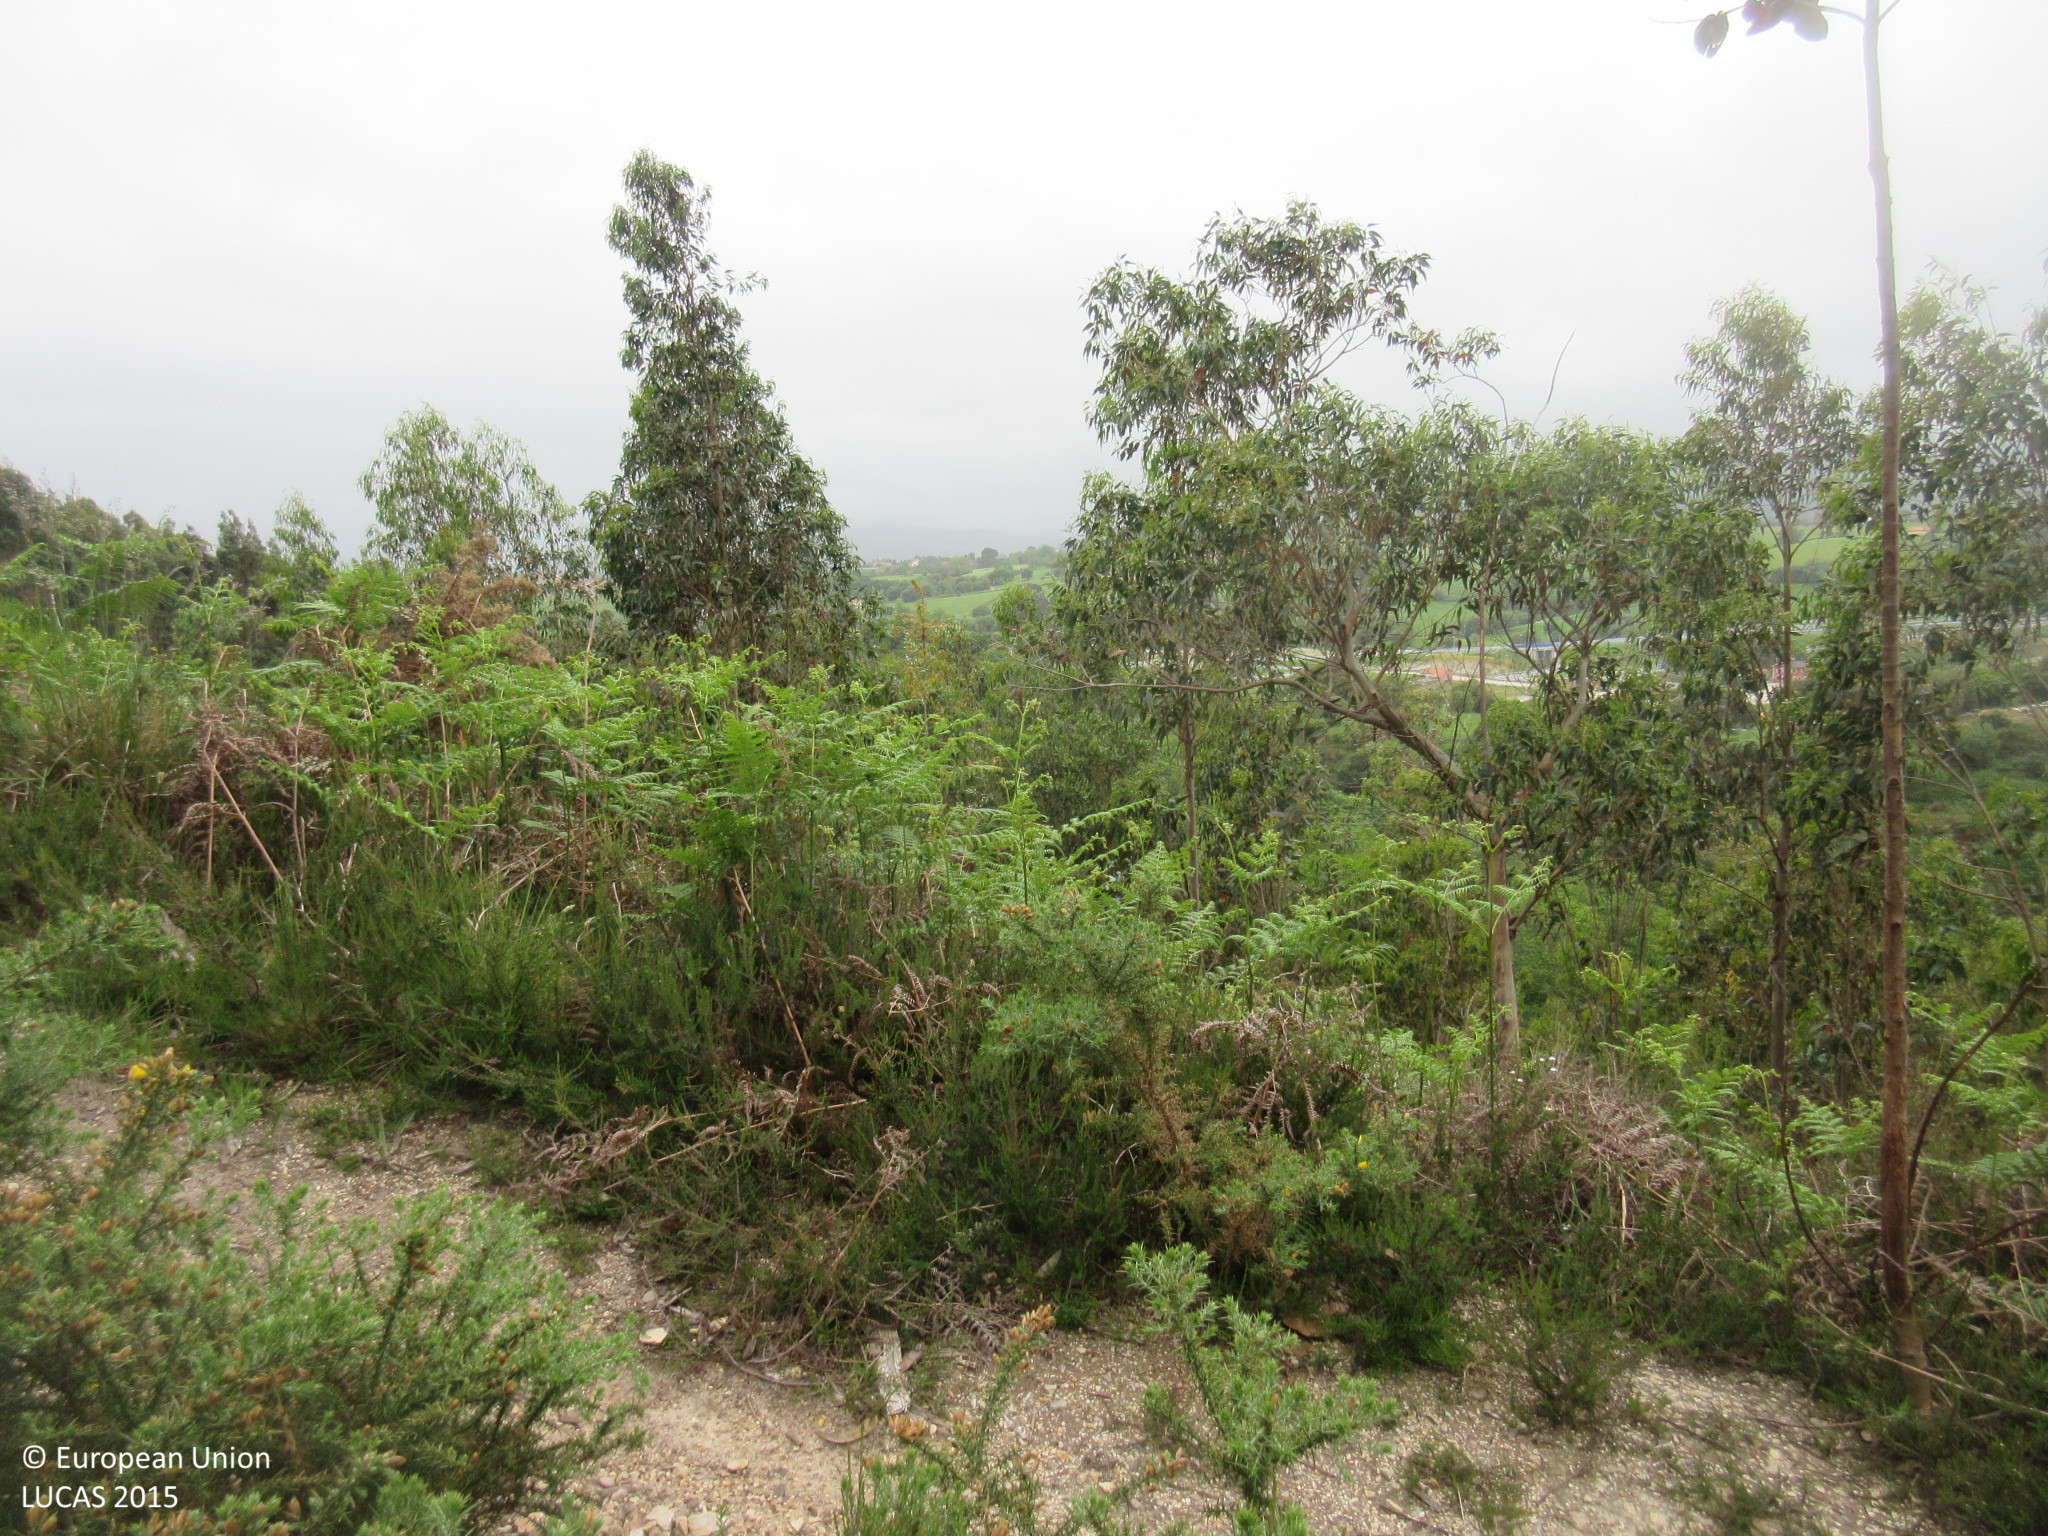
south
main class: Woodland
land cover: Broadleaved woodland
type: exotic forest
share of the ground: 50 - 75 %
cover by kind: broadleaved forest trees 60 %, shrubs 40 %
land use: Forestry
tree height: < 5 m
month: May
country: ES
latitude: 43.3894
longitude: -4.5671
